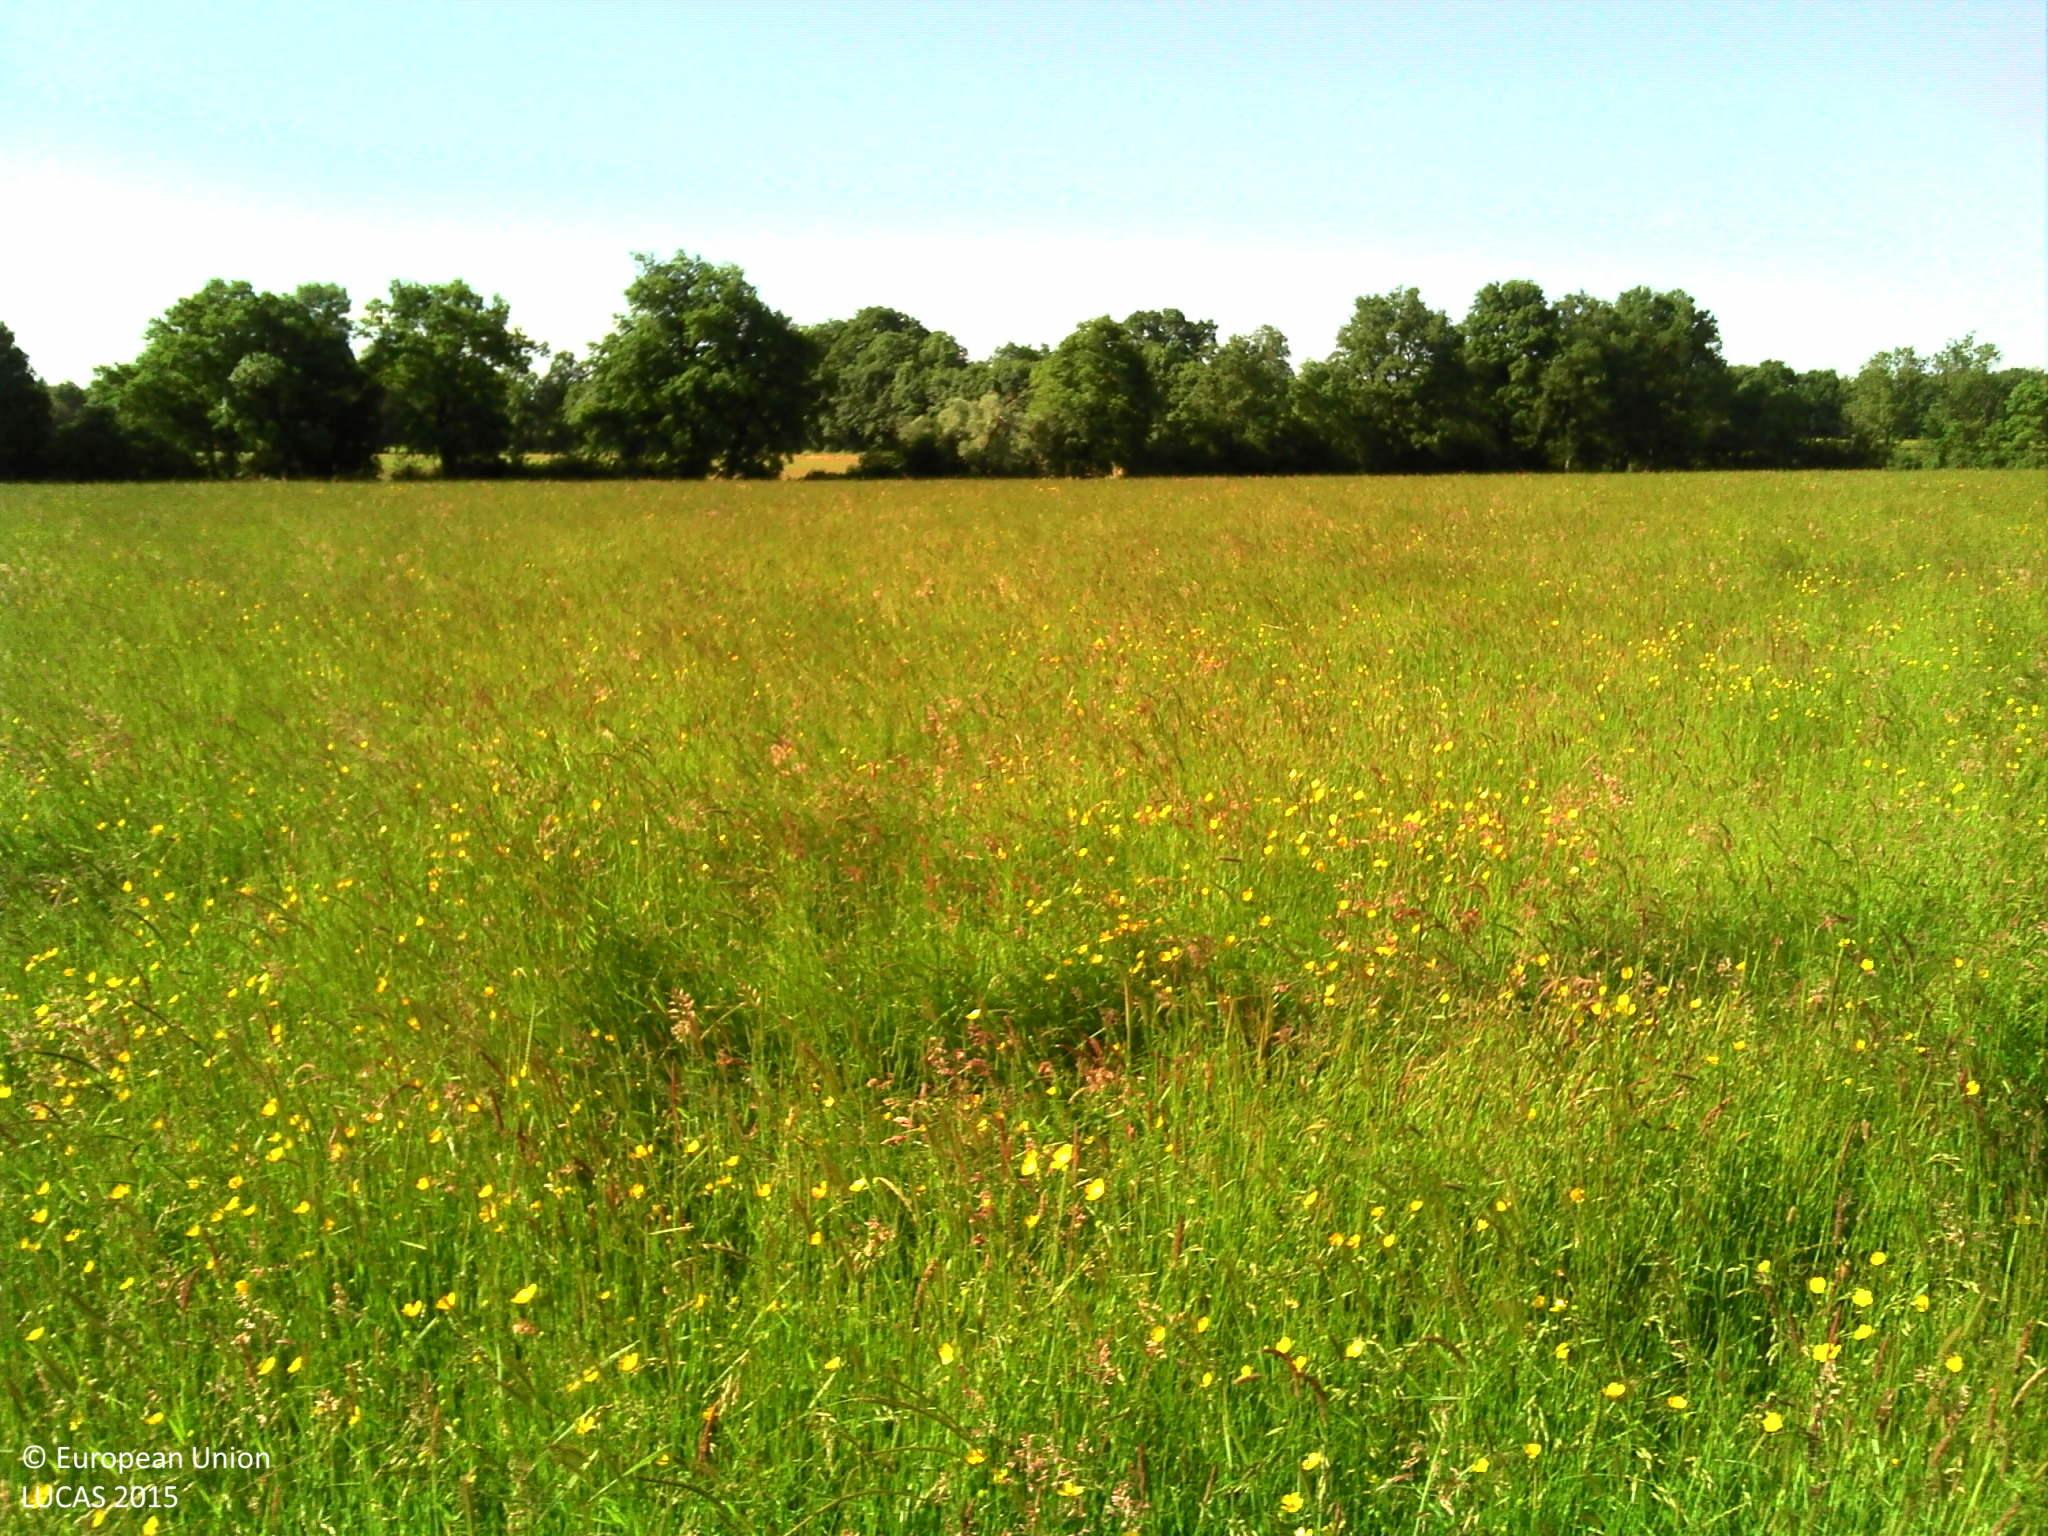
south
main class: Grassland
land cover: Grassland without tree/shrub cover
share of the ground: > 75 %
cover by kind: herbaceous plants 100 %
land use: Agriculture (excluding fallow land and kitchen gardens)
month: June
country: FR
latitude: 46.9654
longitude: 2.9115
